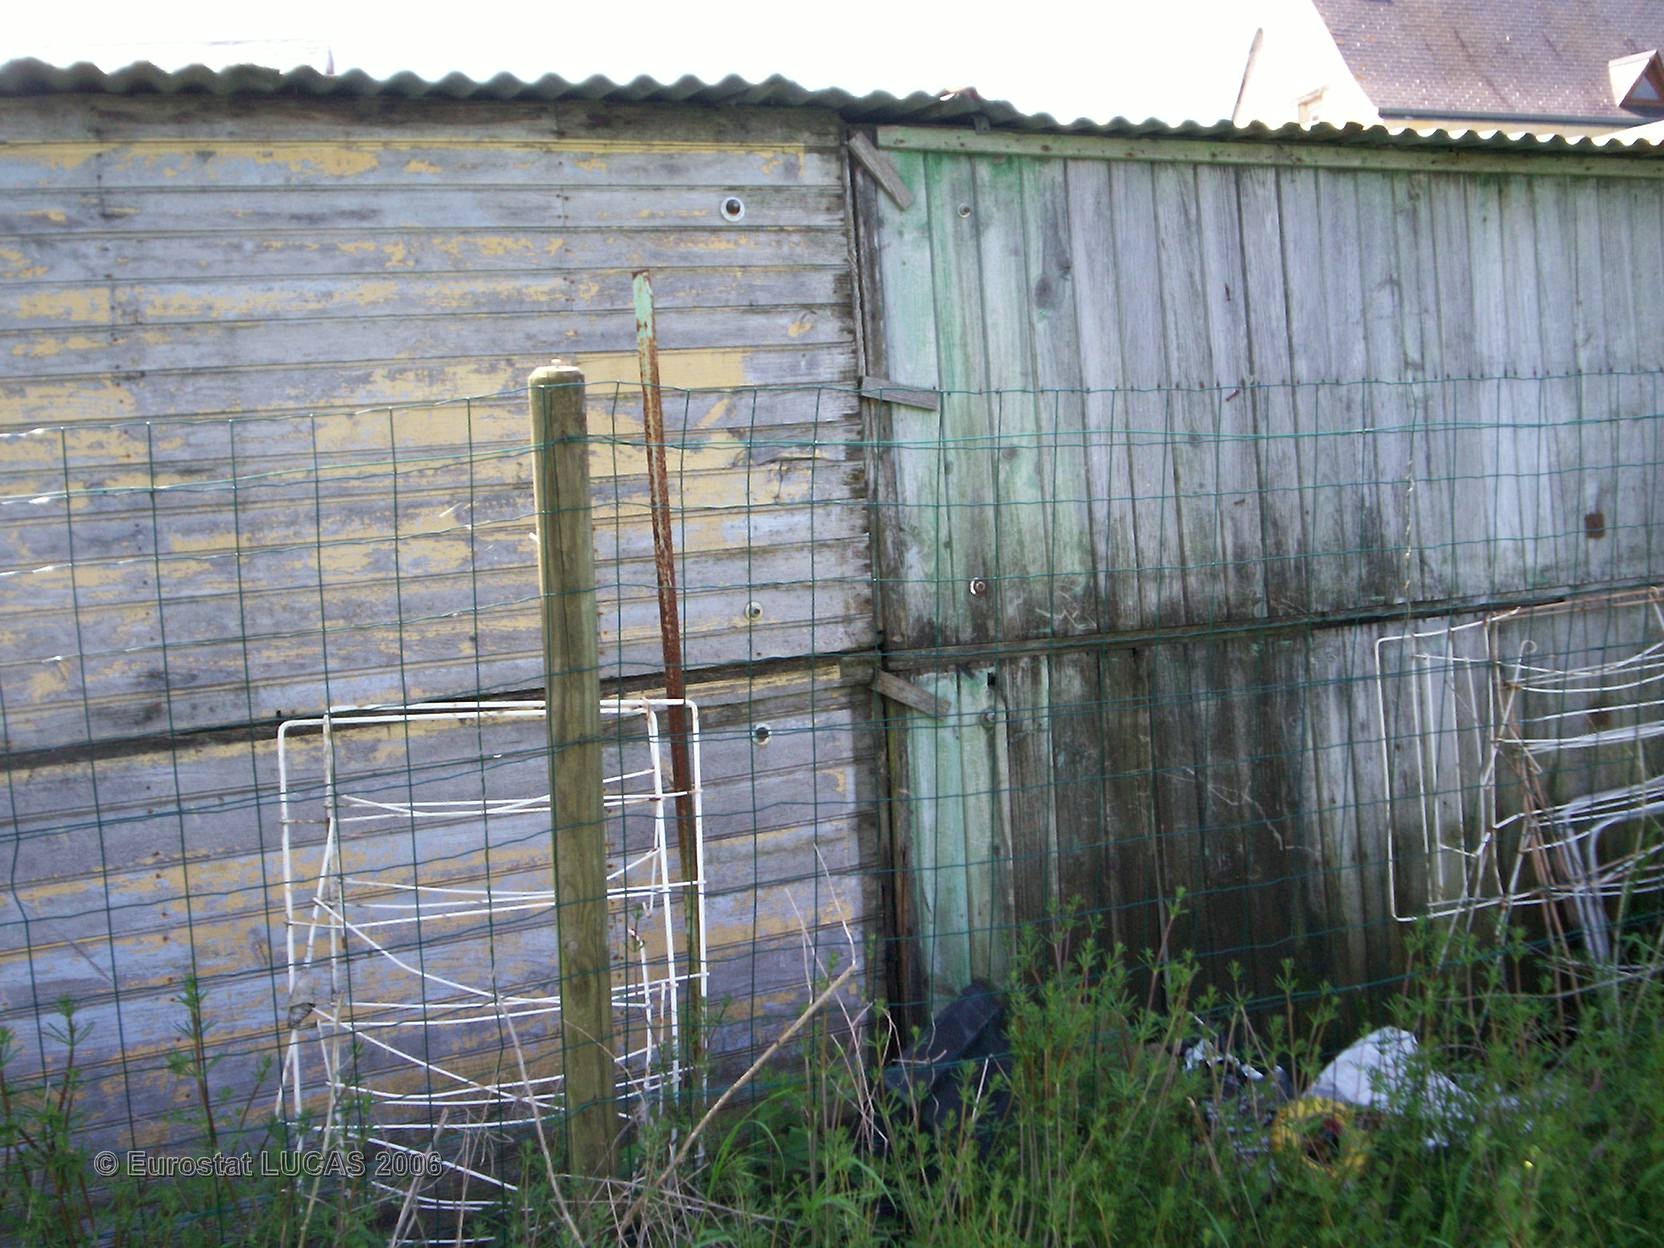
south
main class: Cropland
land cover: Common wheat
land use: Agriculture (excluding fallow land and kitchen gardens)
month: May
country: FR
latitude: 47.2659
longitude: 0.2631
